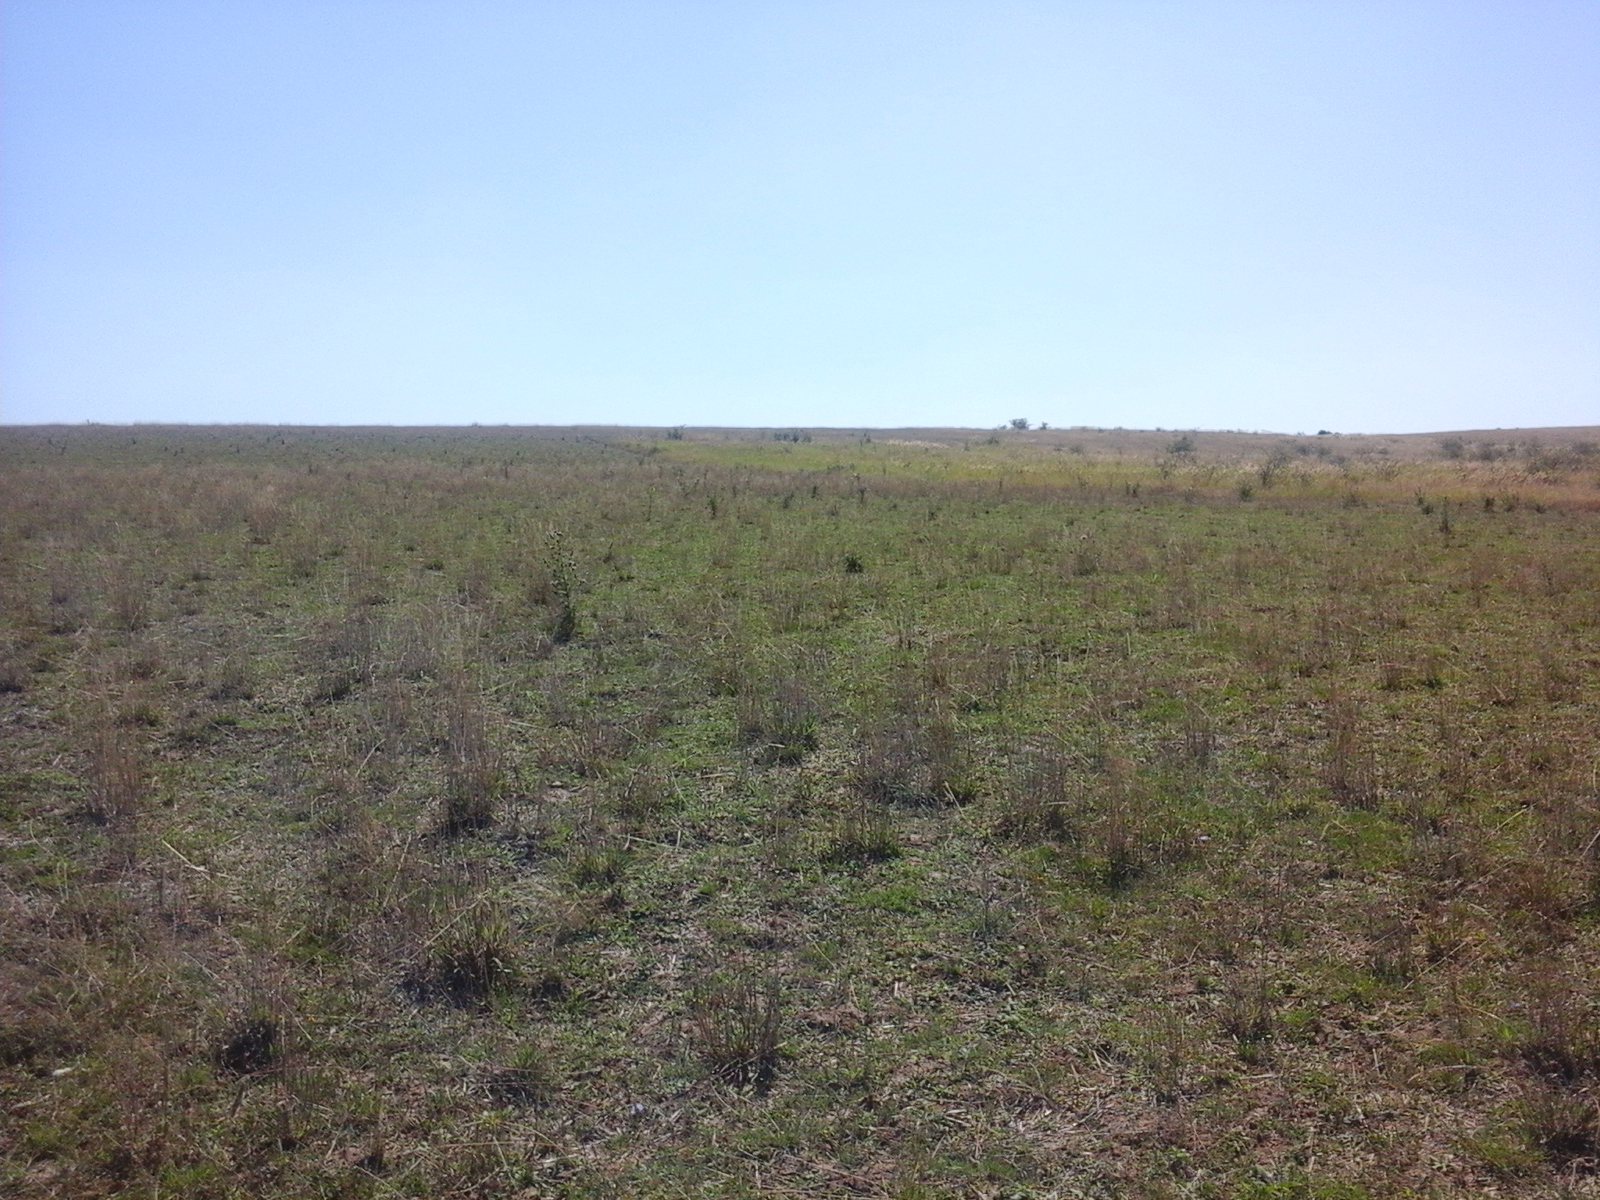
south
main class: Grassland
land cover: Grassland without tree/shrub cover
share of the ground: > 75 %
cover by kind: herbaceous plants 100 %
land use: Agriculture (excluding fallow land and kitchen gardens)
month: August
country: RO
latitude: 45.5988
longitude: 21.6886
